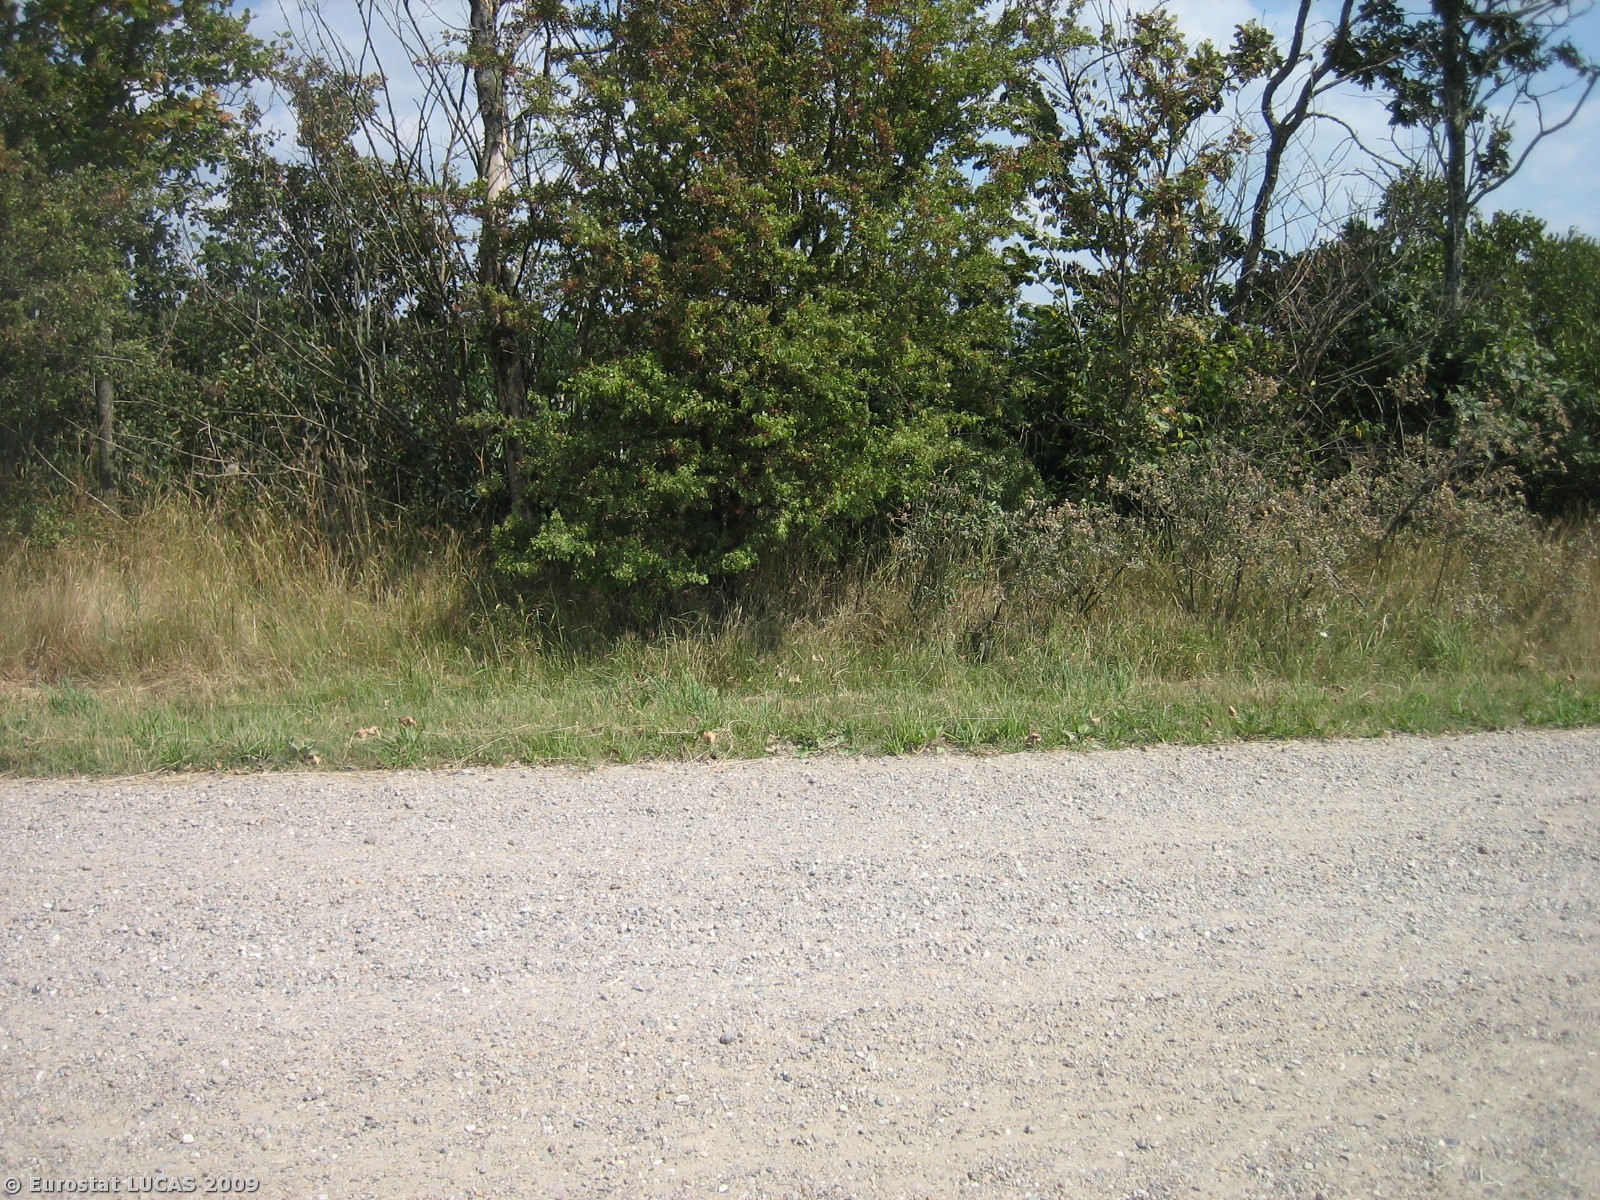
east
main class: Cropland
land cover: Common wheat
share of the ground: > 75 %
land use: Agriculture (excluding fallow land and kitchen gardens)
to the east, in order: Common wheat; Grass margins; Tracks; Grass margins; Broadleaved woodland; Maize; Bare land; Potatoes
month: July
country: DK
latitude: 55.3904
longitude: 8.7224
